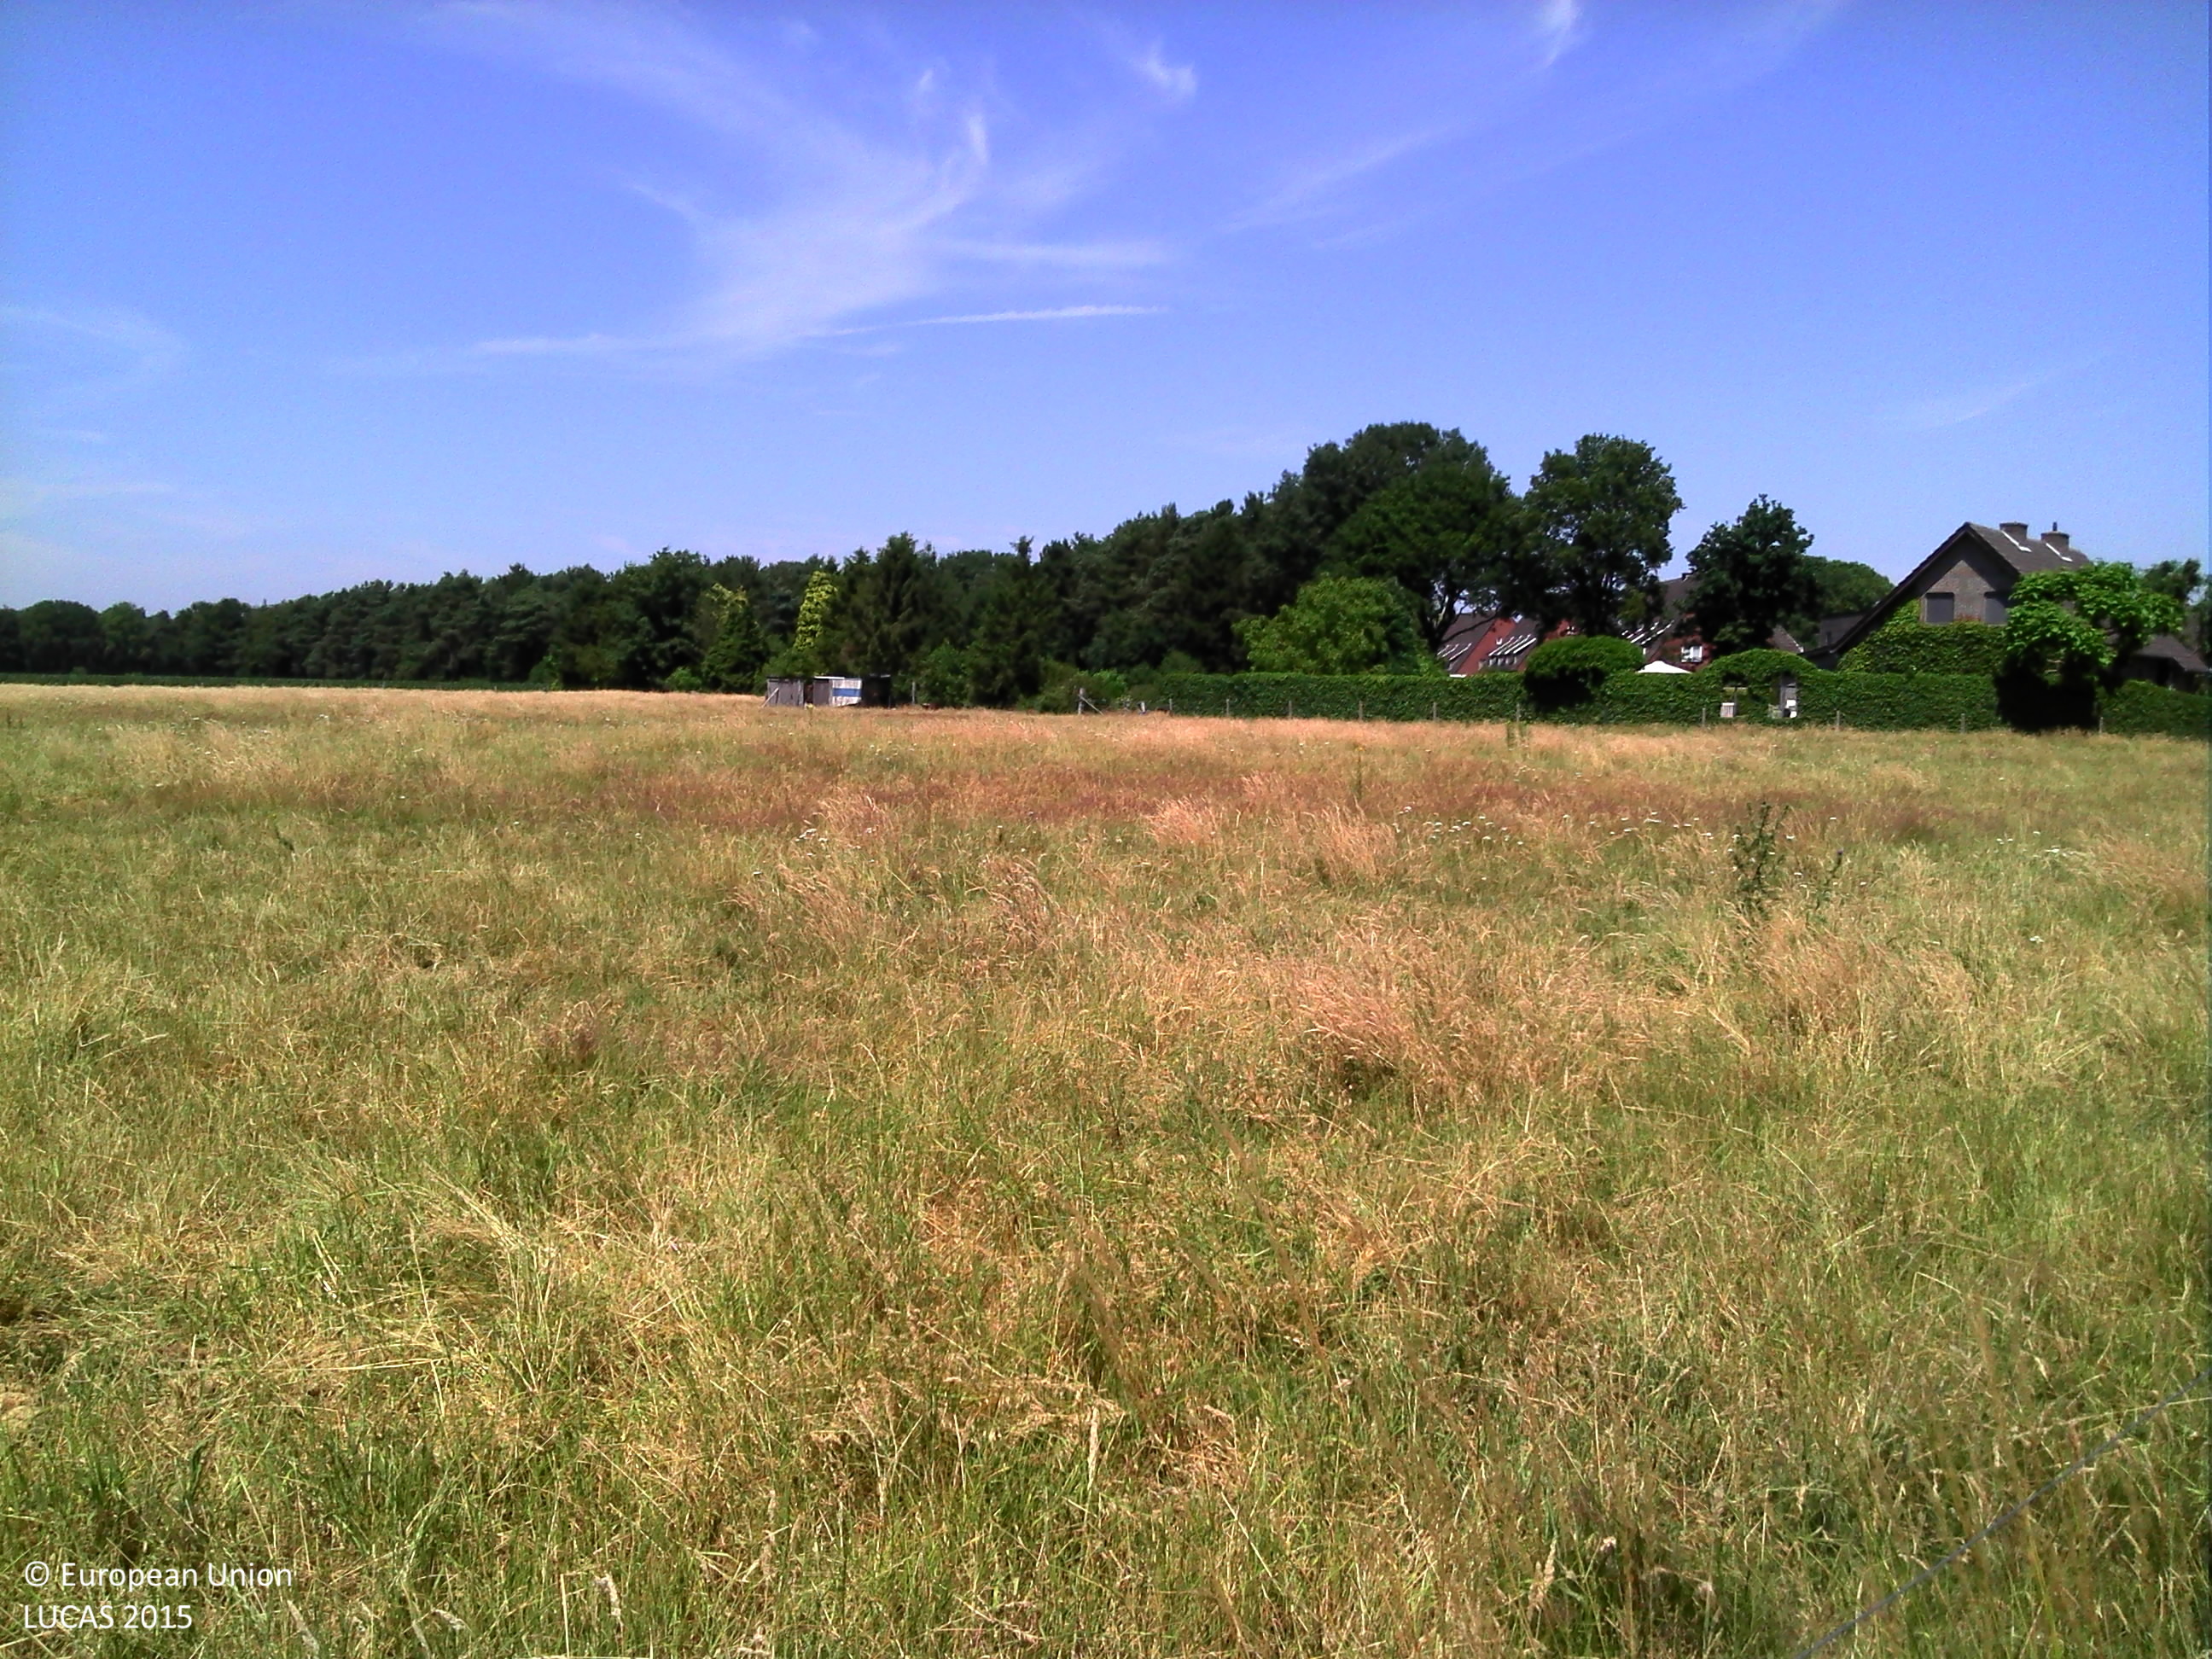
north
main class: Grassland
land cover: Grassland without tree/shrub cover
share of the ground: > 75 %
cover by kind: herbaceous plants 100 %
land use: Agriculture (excluding fallow land and kitchen gardens)
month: July
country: BE
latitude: 51.1387
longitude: 5.4674
